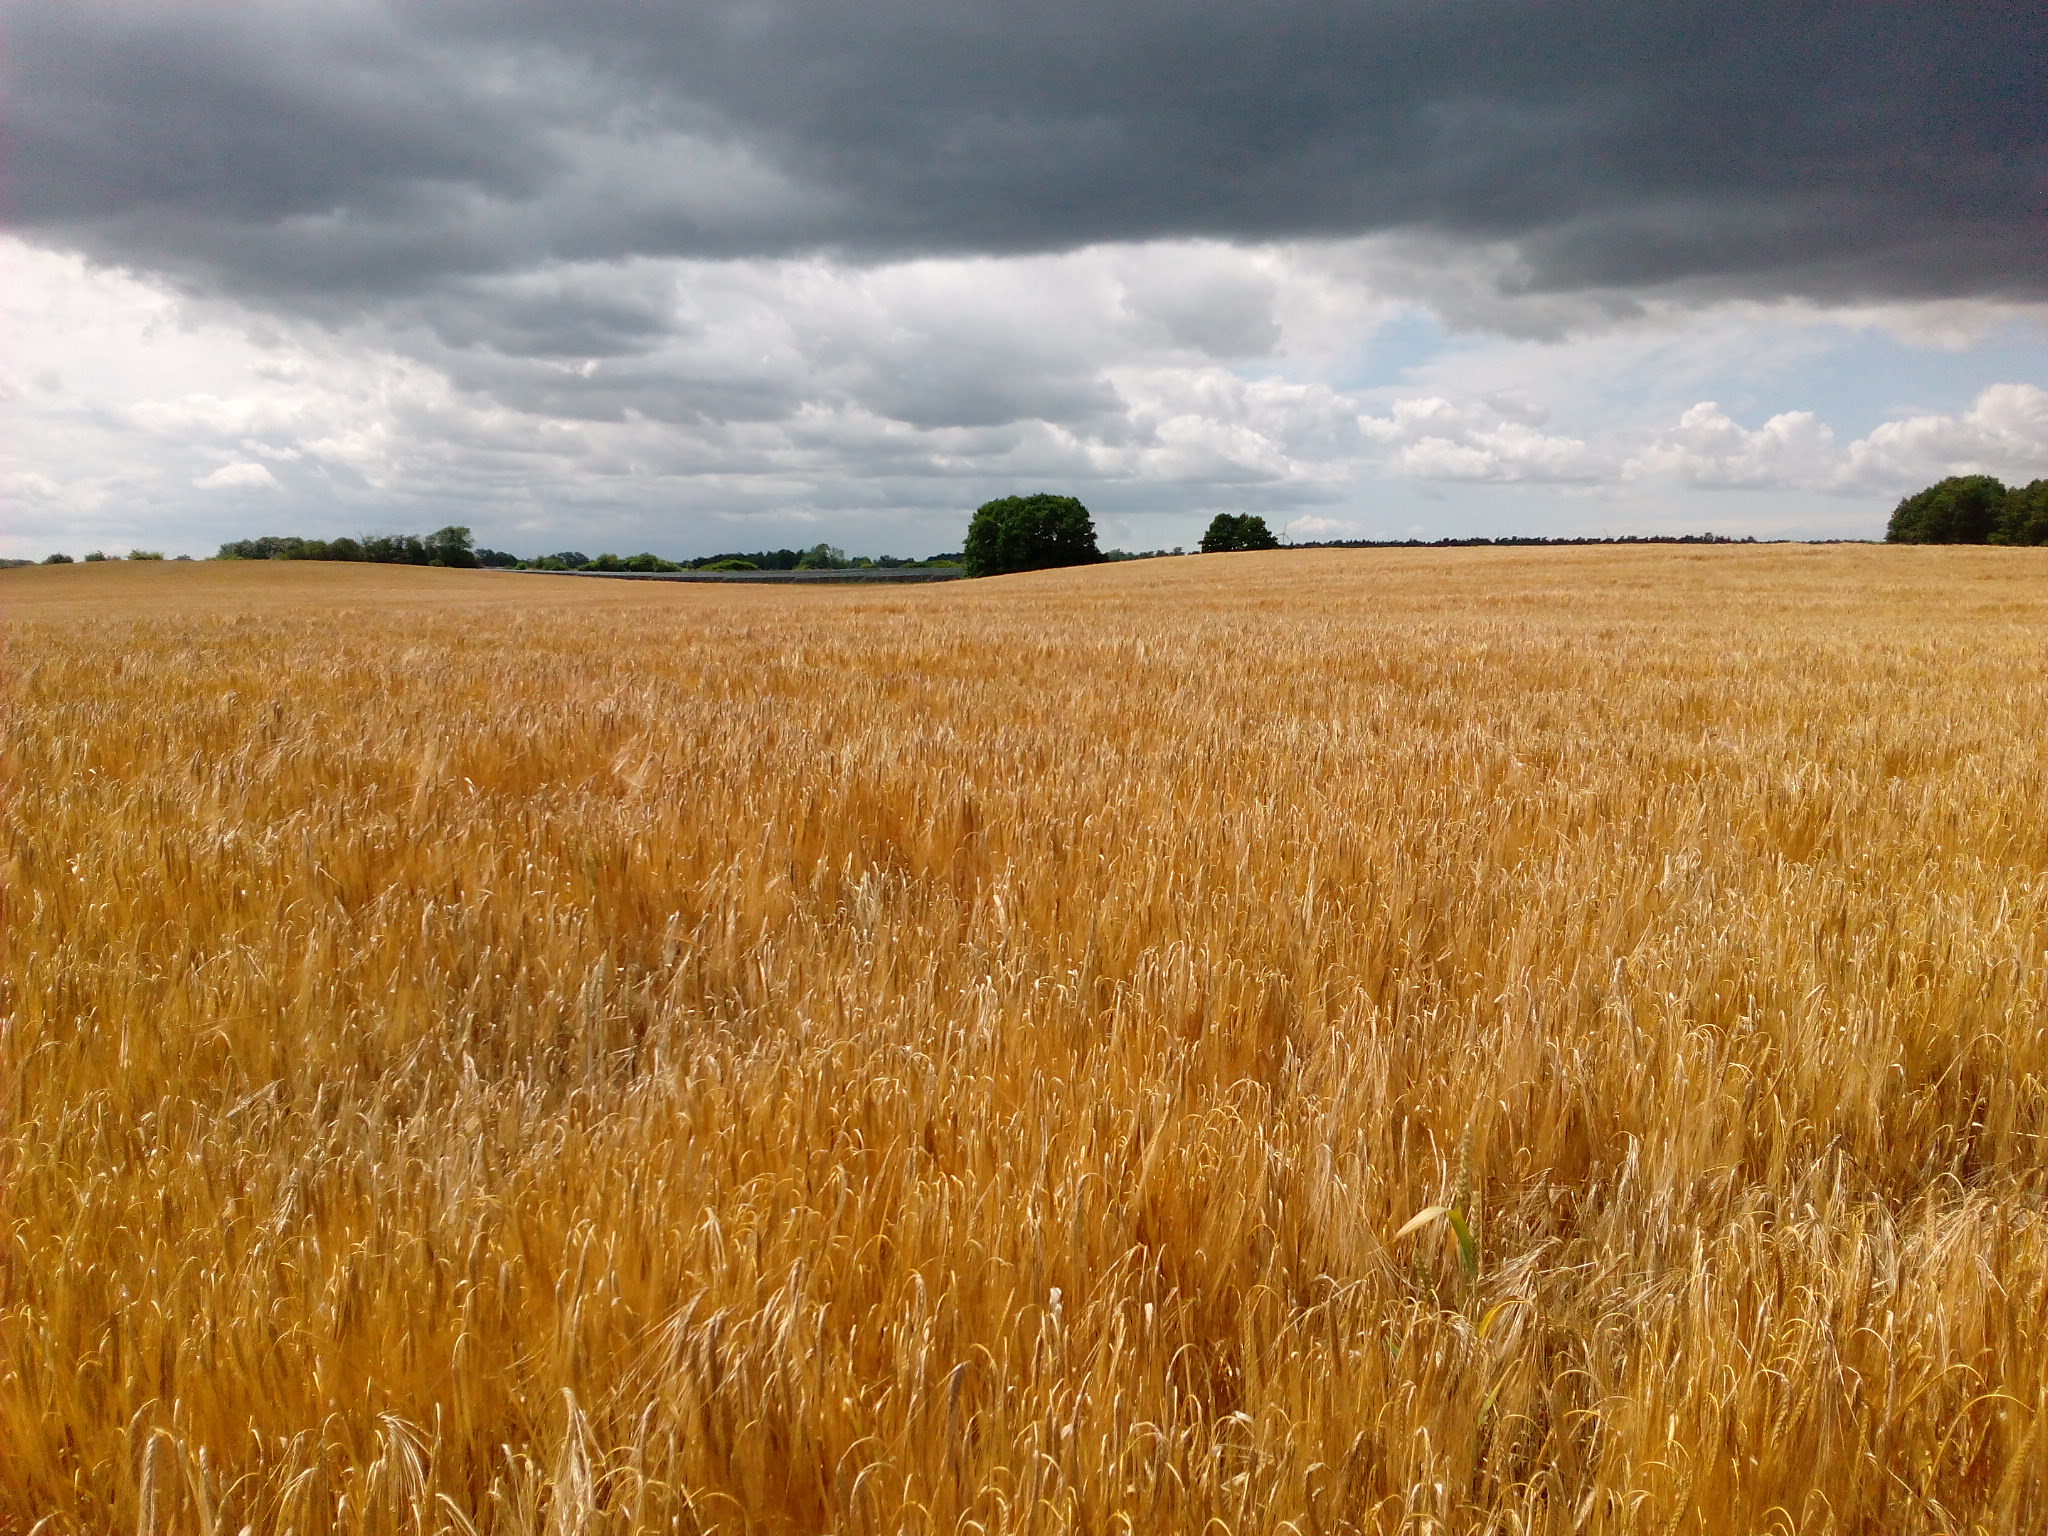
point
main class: Cropland
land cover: Barley
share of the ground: > 75 %
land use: Agriculture (excluding fallow land and kitchen gardens)
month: July
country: DE
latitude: 53.4340
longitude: 14.2906
